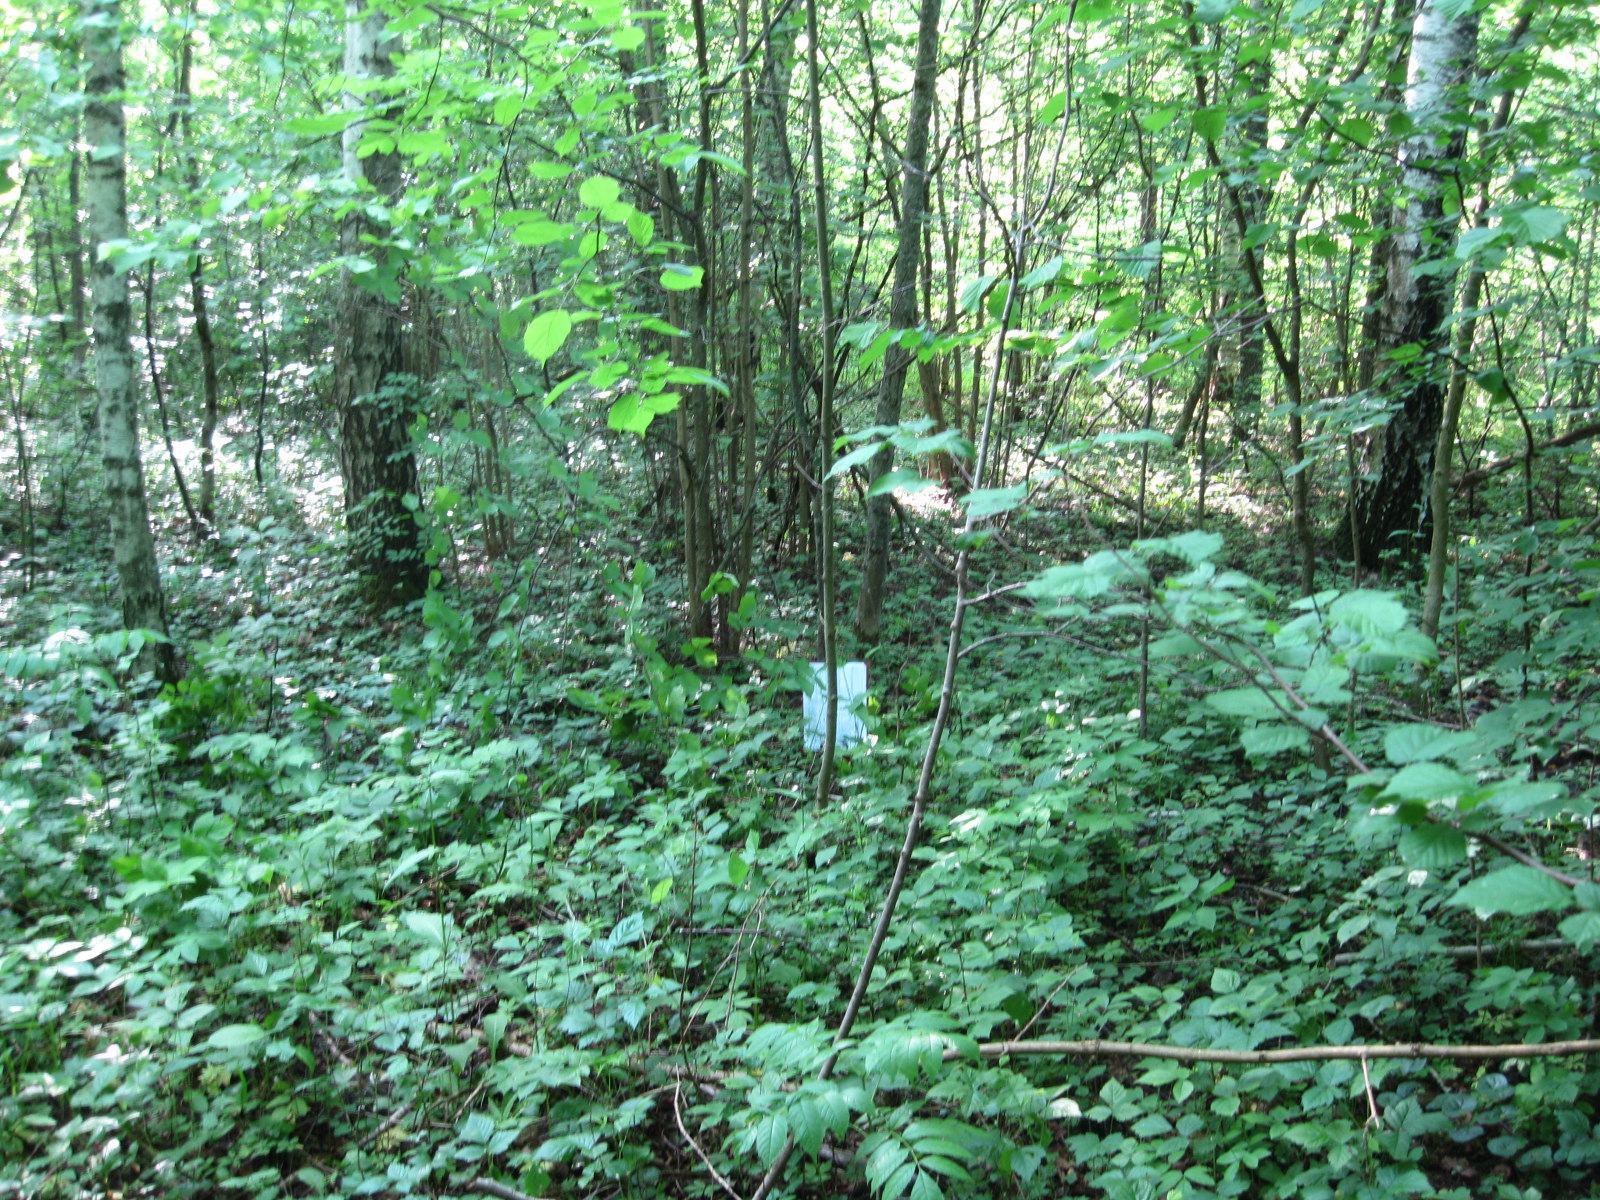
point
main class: Woodland
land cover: Broadleaved woodland
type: non-riverine alder, birch or aspen forest
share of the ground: > 75 %
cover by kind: broadleaved forest trees 80 %, herbaceous plants 15 %, shrubs 5 %
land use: Forestry
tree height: > 5 m
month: June
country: LT
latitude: 55.9026
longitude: 23.8886
